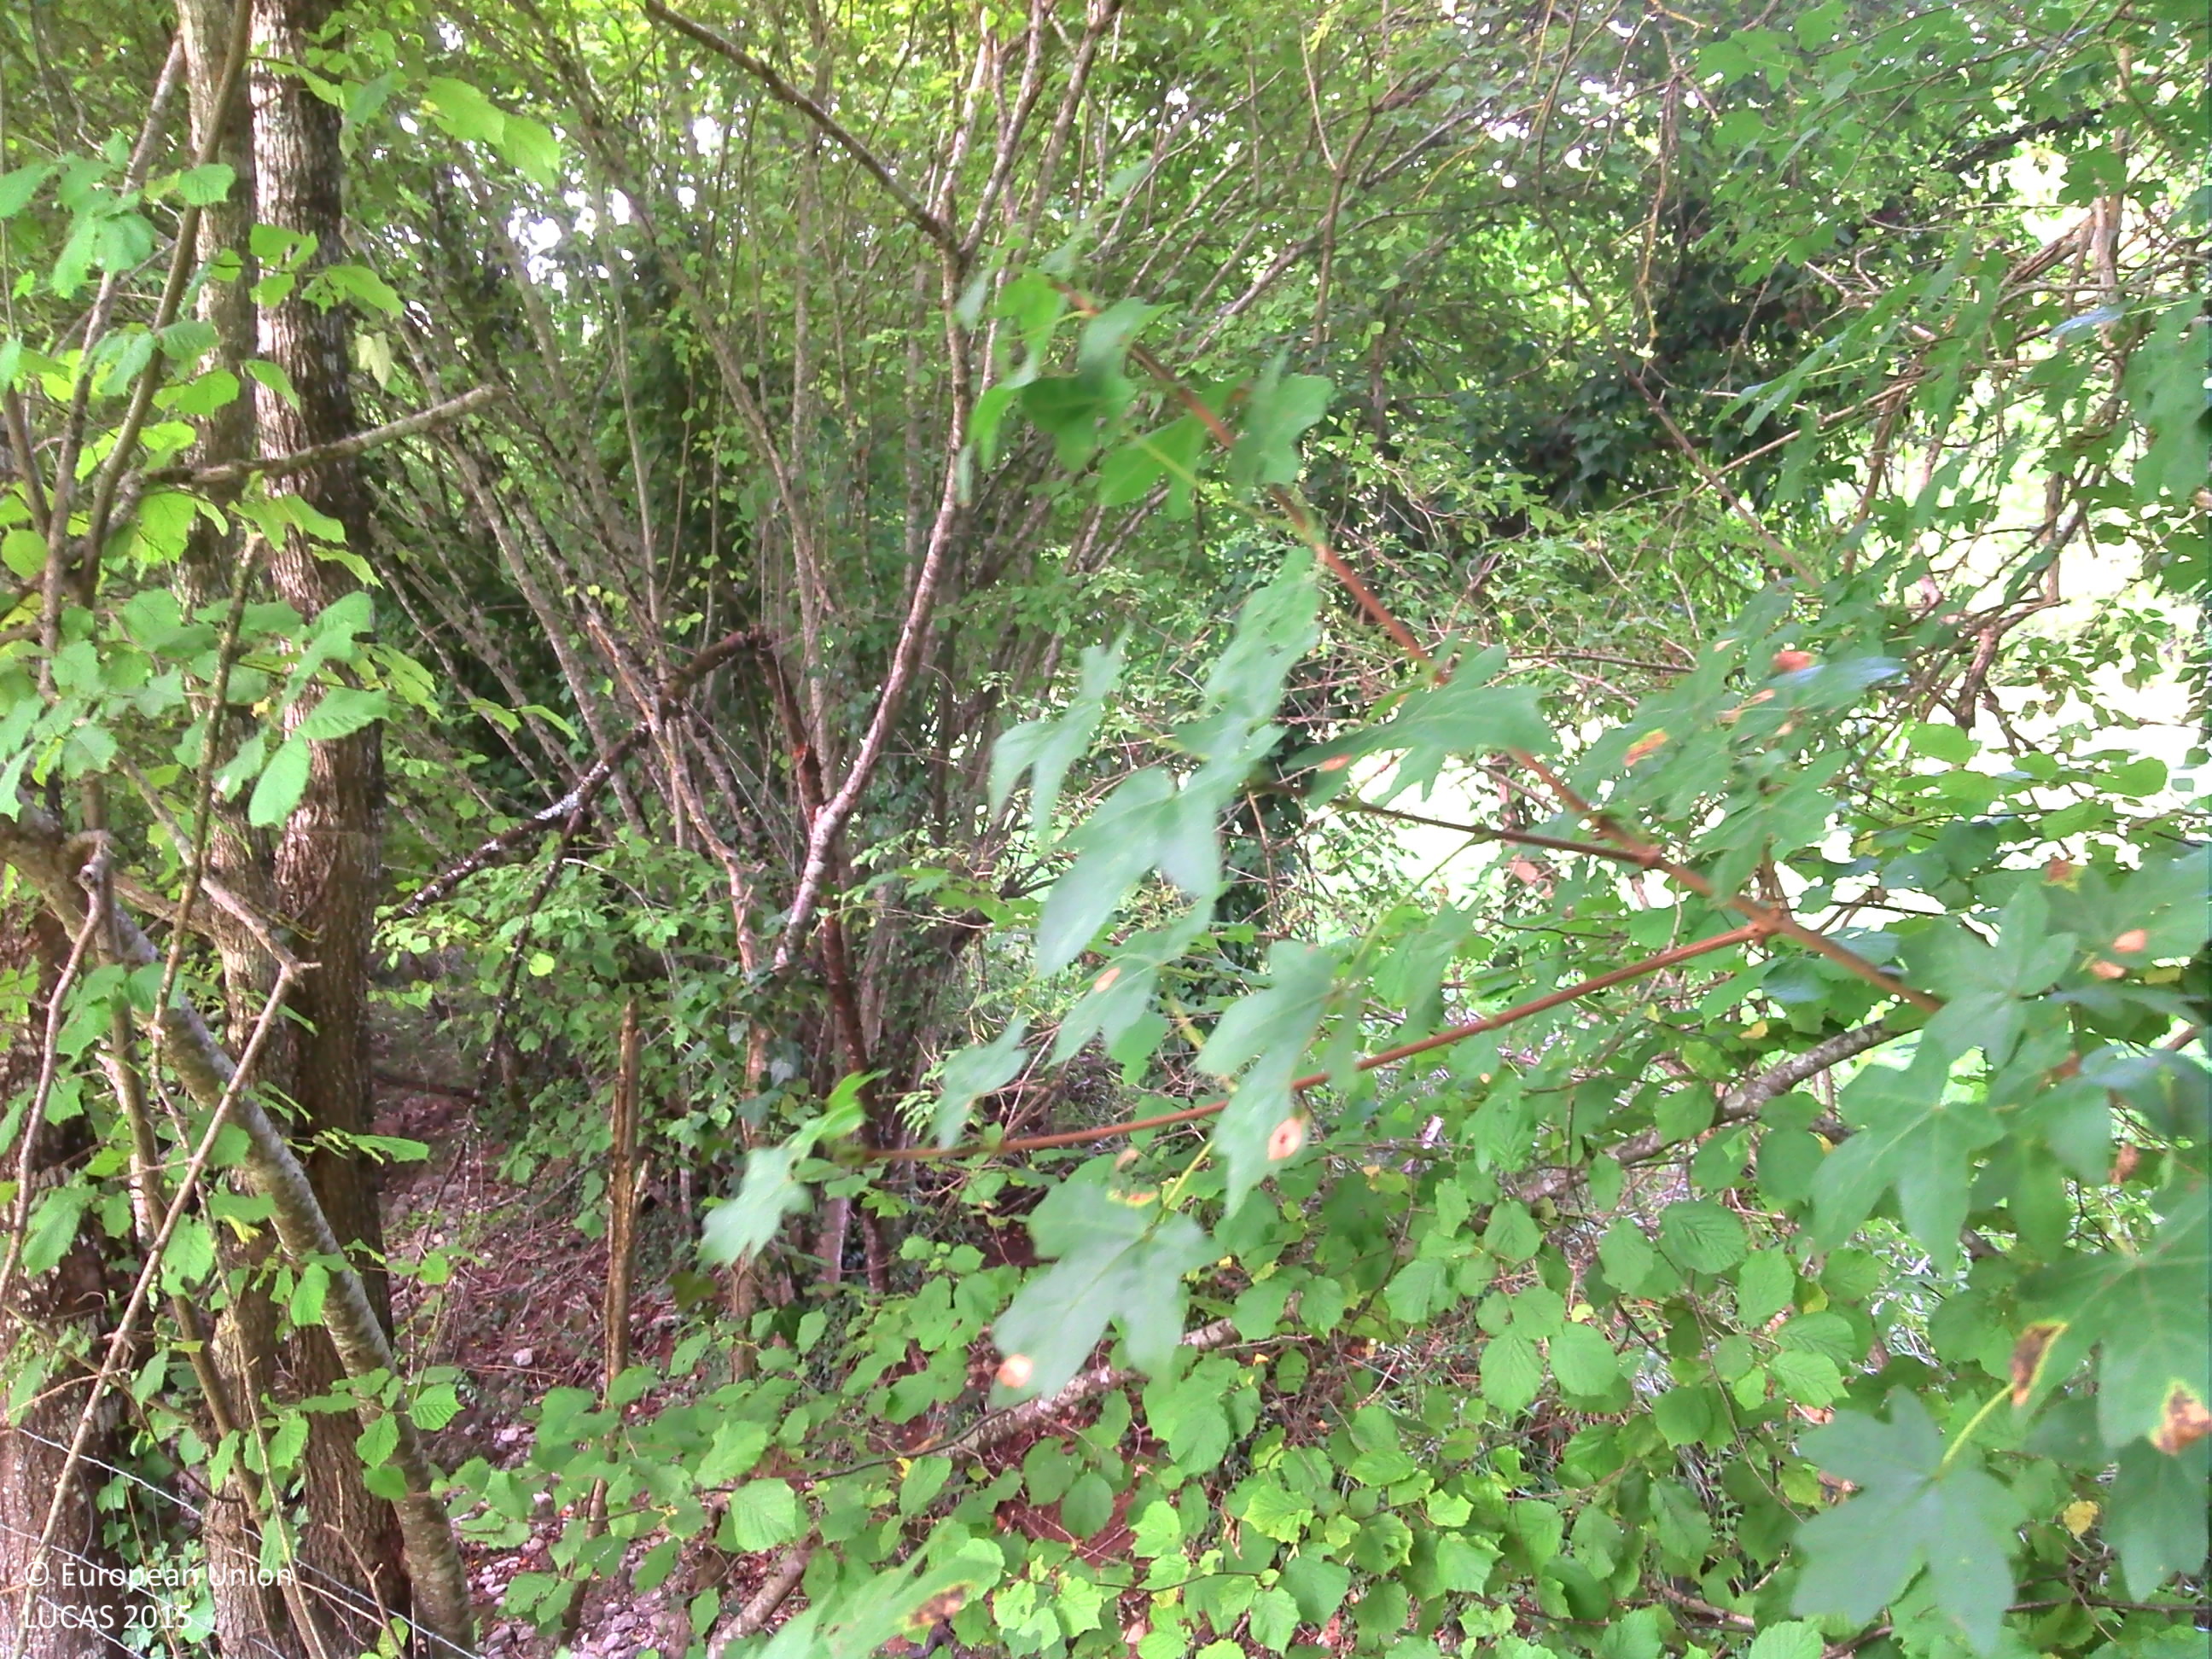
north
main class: Woodland
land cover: Broadleaved woodland
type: non-riverine alder, birch or aspen forest
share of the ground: > 75 %
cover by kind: broadleaved forest trees 60 %, shrubs 20 %, herbaceous plants 20 %
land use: Semi-natural and natural areas not in use
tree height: > 5 m
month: September
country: FR
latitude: 44.6527
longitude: 1.4857
